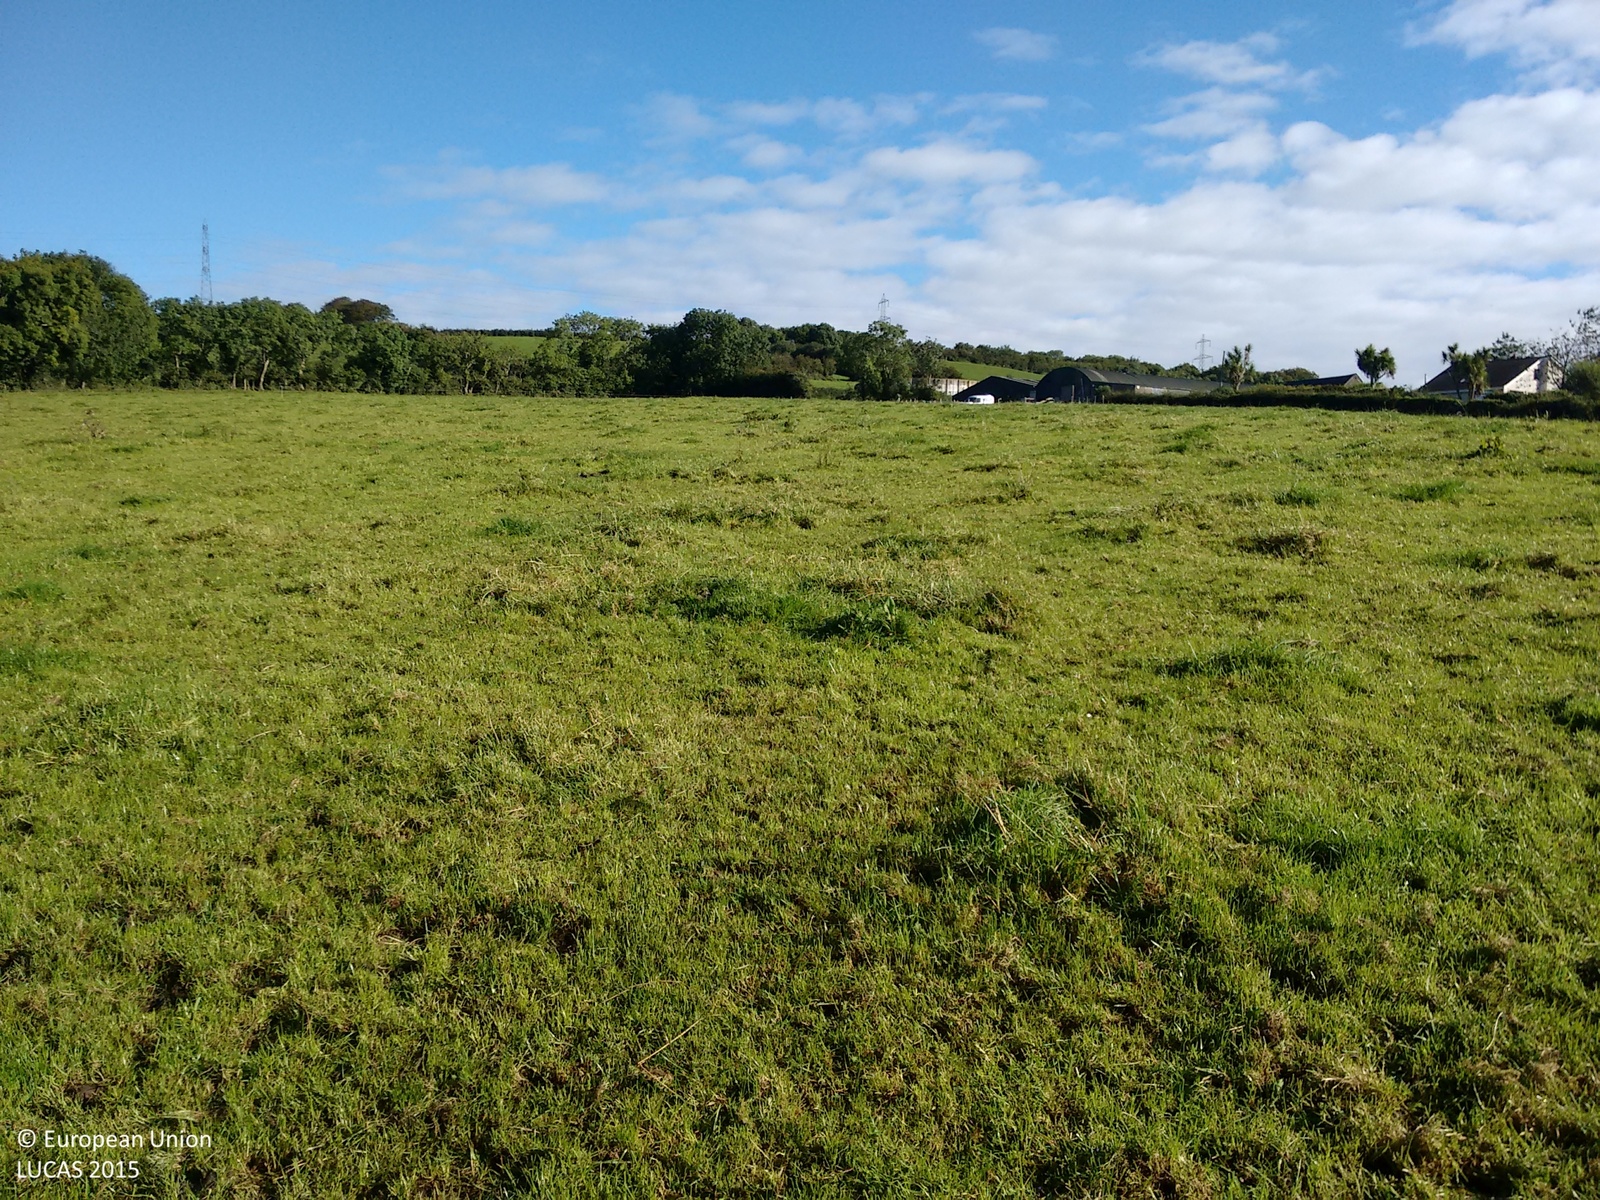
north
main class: Grassland
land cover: Grassland without tree/shrub cover
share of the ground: > 75 %
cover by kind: herbaceous plants 100 %
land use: Agriculture (excluding fallow land and kitchen gardens)
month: September
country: GB
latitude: 54.7357
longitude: -5.8376
